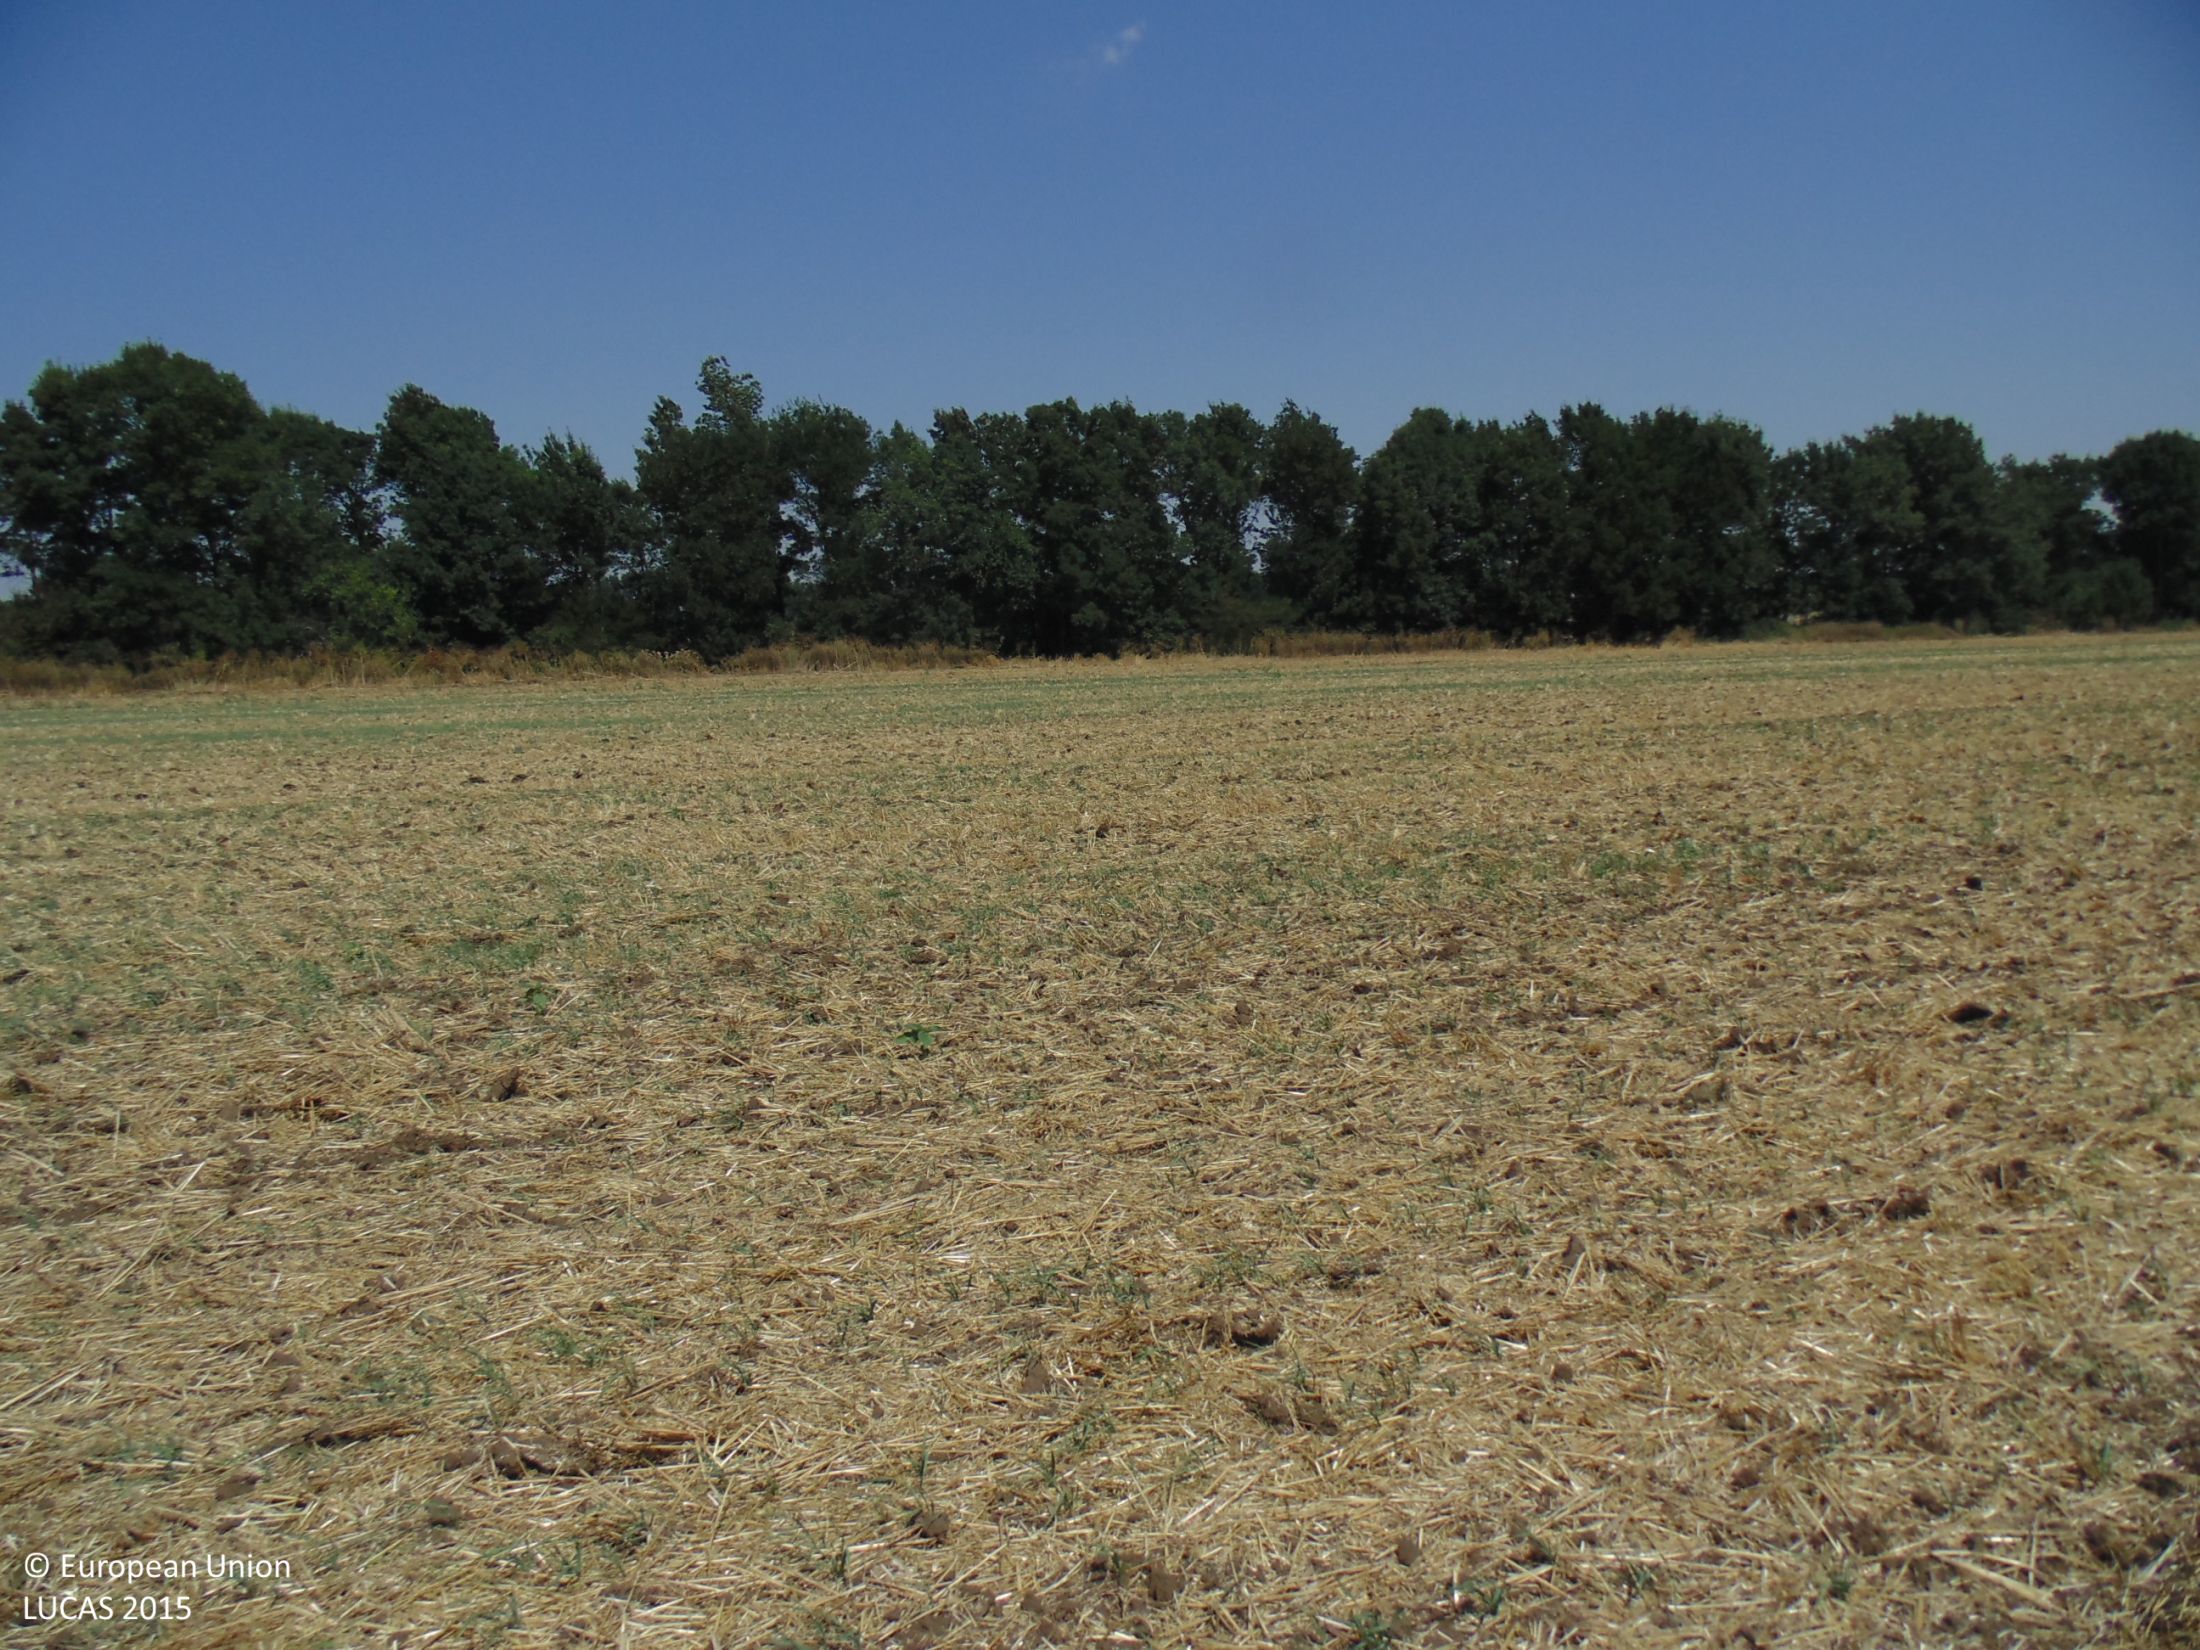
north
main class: Cropland
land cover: Common wheat
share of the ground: < 10 %
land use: Agriculture (excluding fallow land and kitchen gardens)
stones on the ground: < 10 %
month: August
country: BG
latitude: 43.6920
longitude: 28.2575
